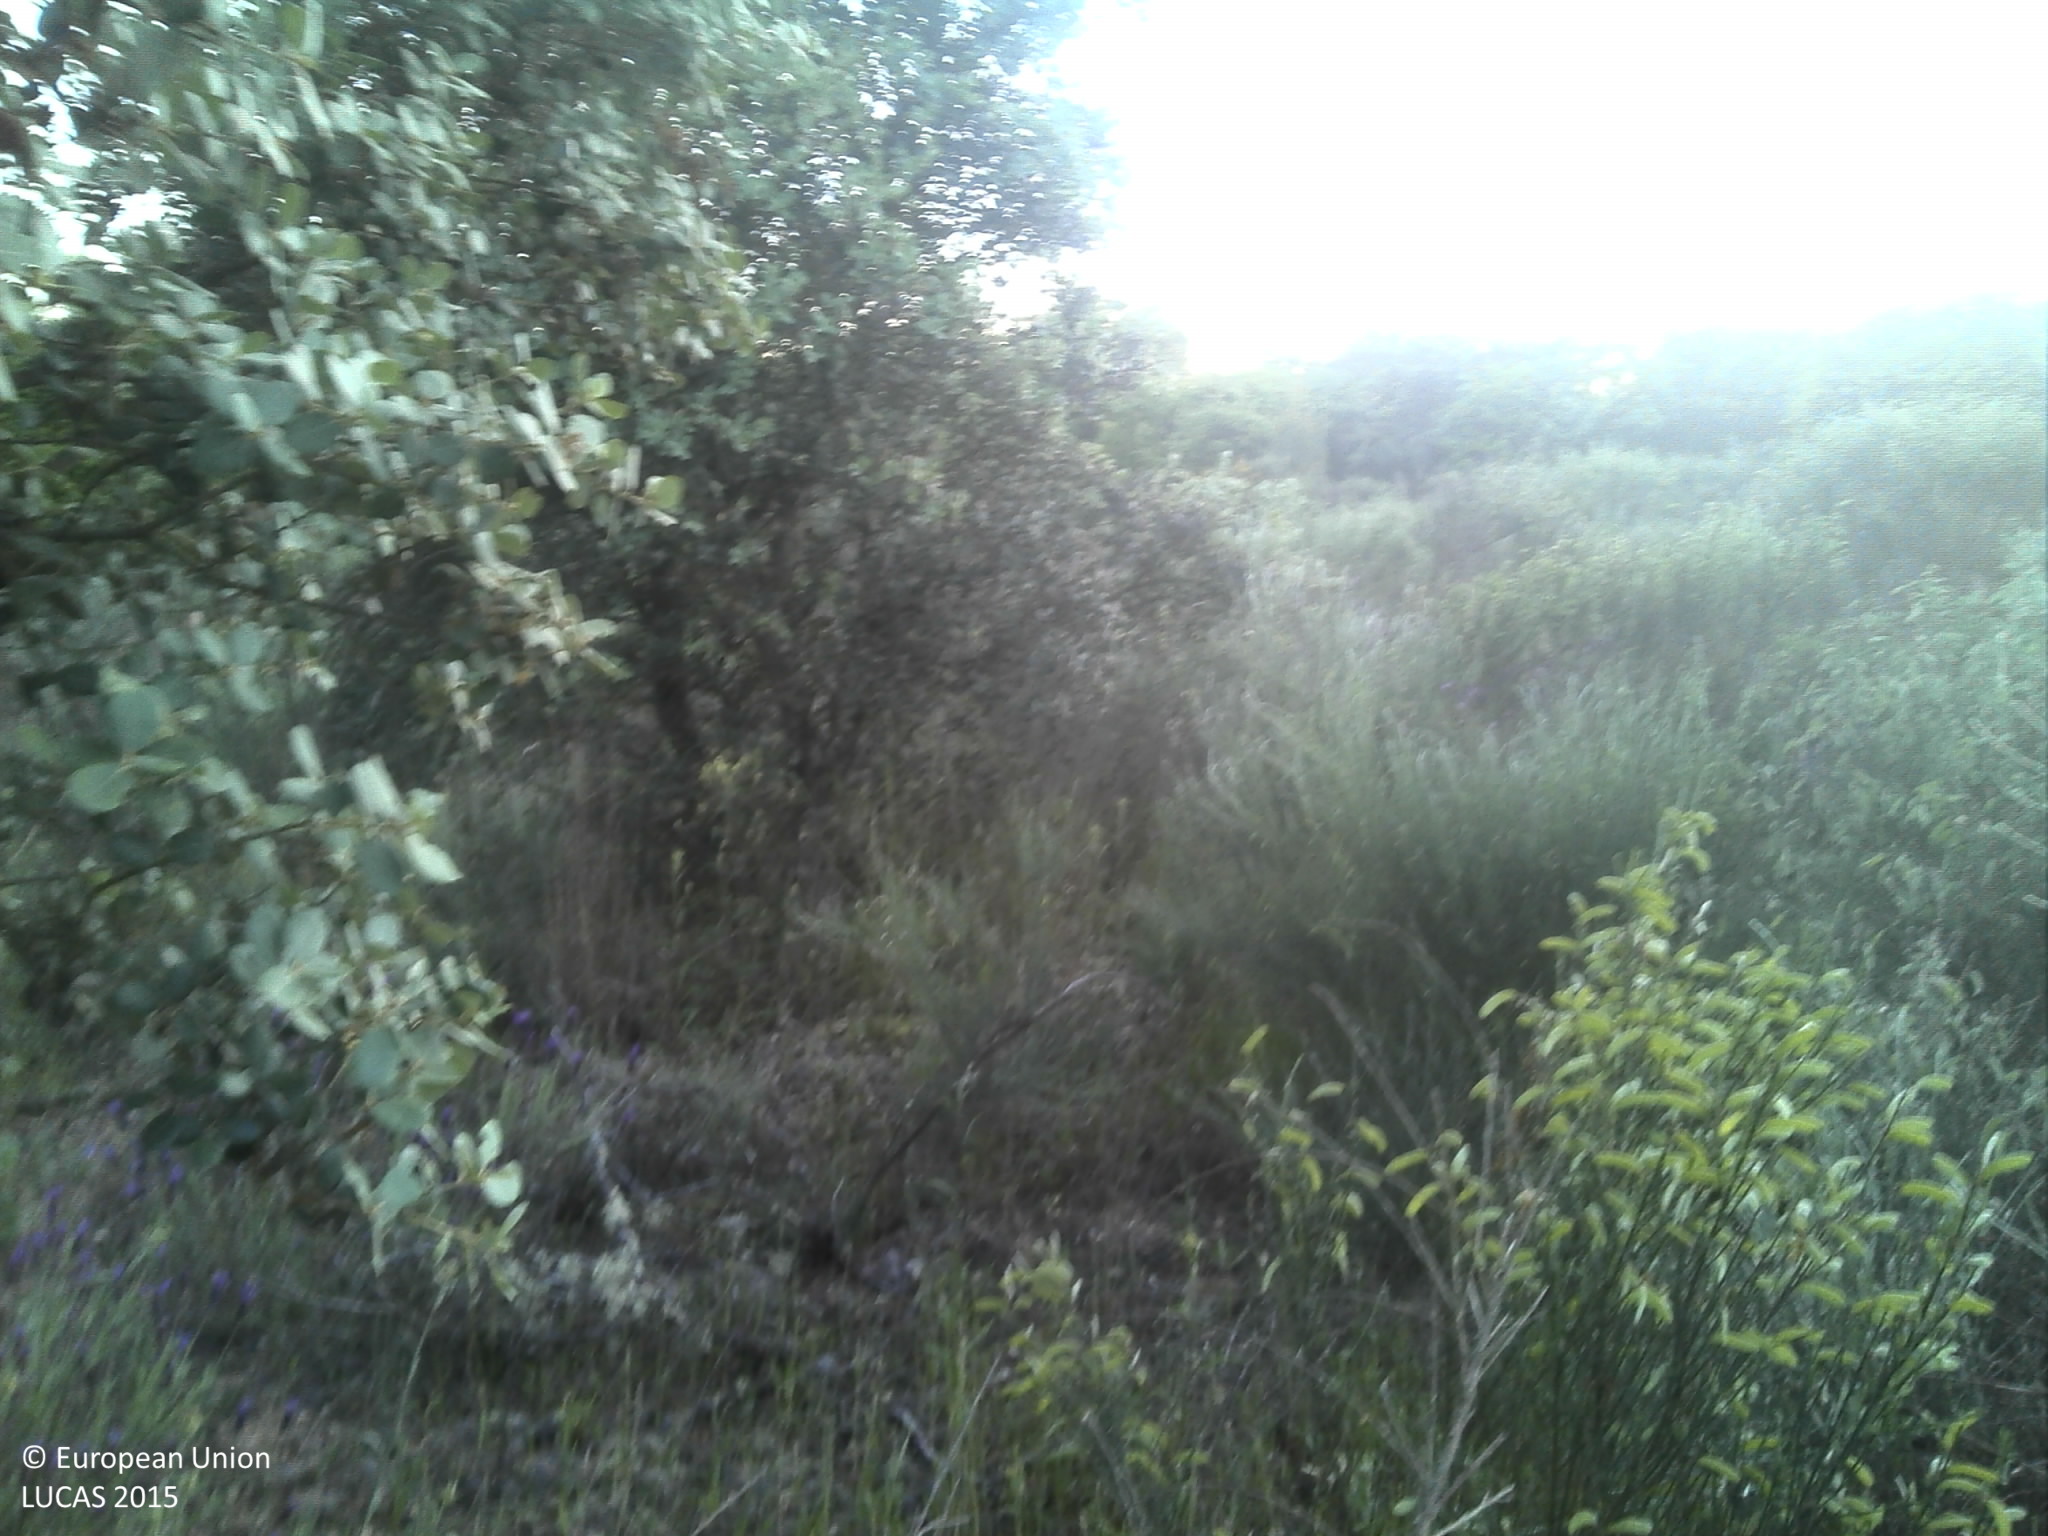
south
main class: Shrubland
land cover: Shrubland with sparse tree cover
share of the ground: > 75 %
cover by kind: shrubs 95 %, broadleaved forest trees 5 %
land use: Abandoned areas
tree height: > 5 m
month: May
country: PT
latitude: 40.6648
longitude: -7.3444
